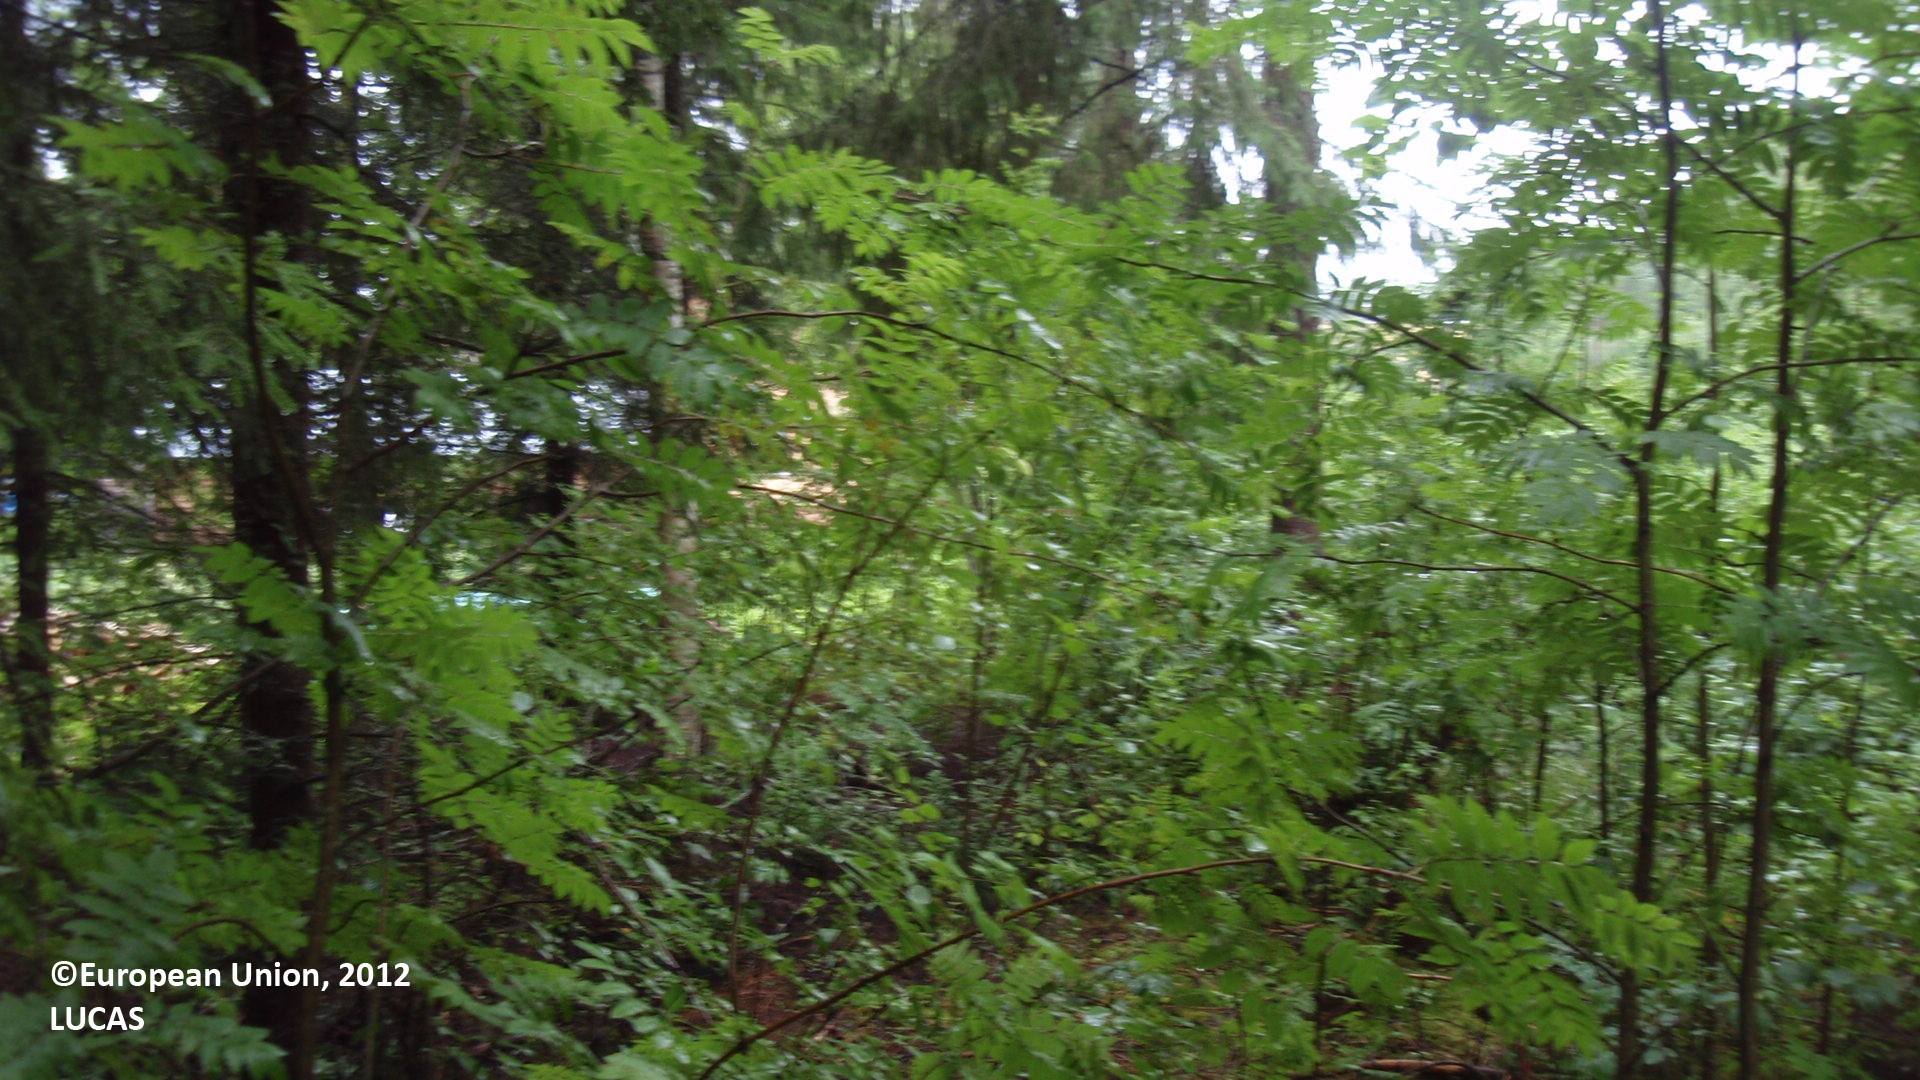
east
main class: Woodland
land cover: Spruce dominated coniferous woodland
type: boreal forest
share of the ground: > 75 %
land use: Forestry
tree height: > 5 m
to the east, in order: Spruce dominated coniferous woodland; Artificial constructions in urban areas; Broadleaved woodland; Grassland with sparse tree/shrub cover; Broadleaved woodland; Pine dominated mixed woodland; Broadleaved woodland
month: July
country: FI
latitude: 61.6373
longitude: 27.2844
